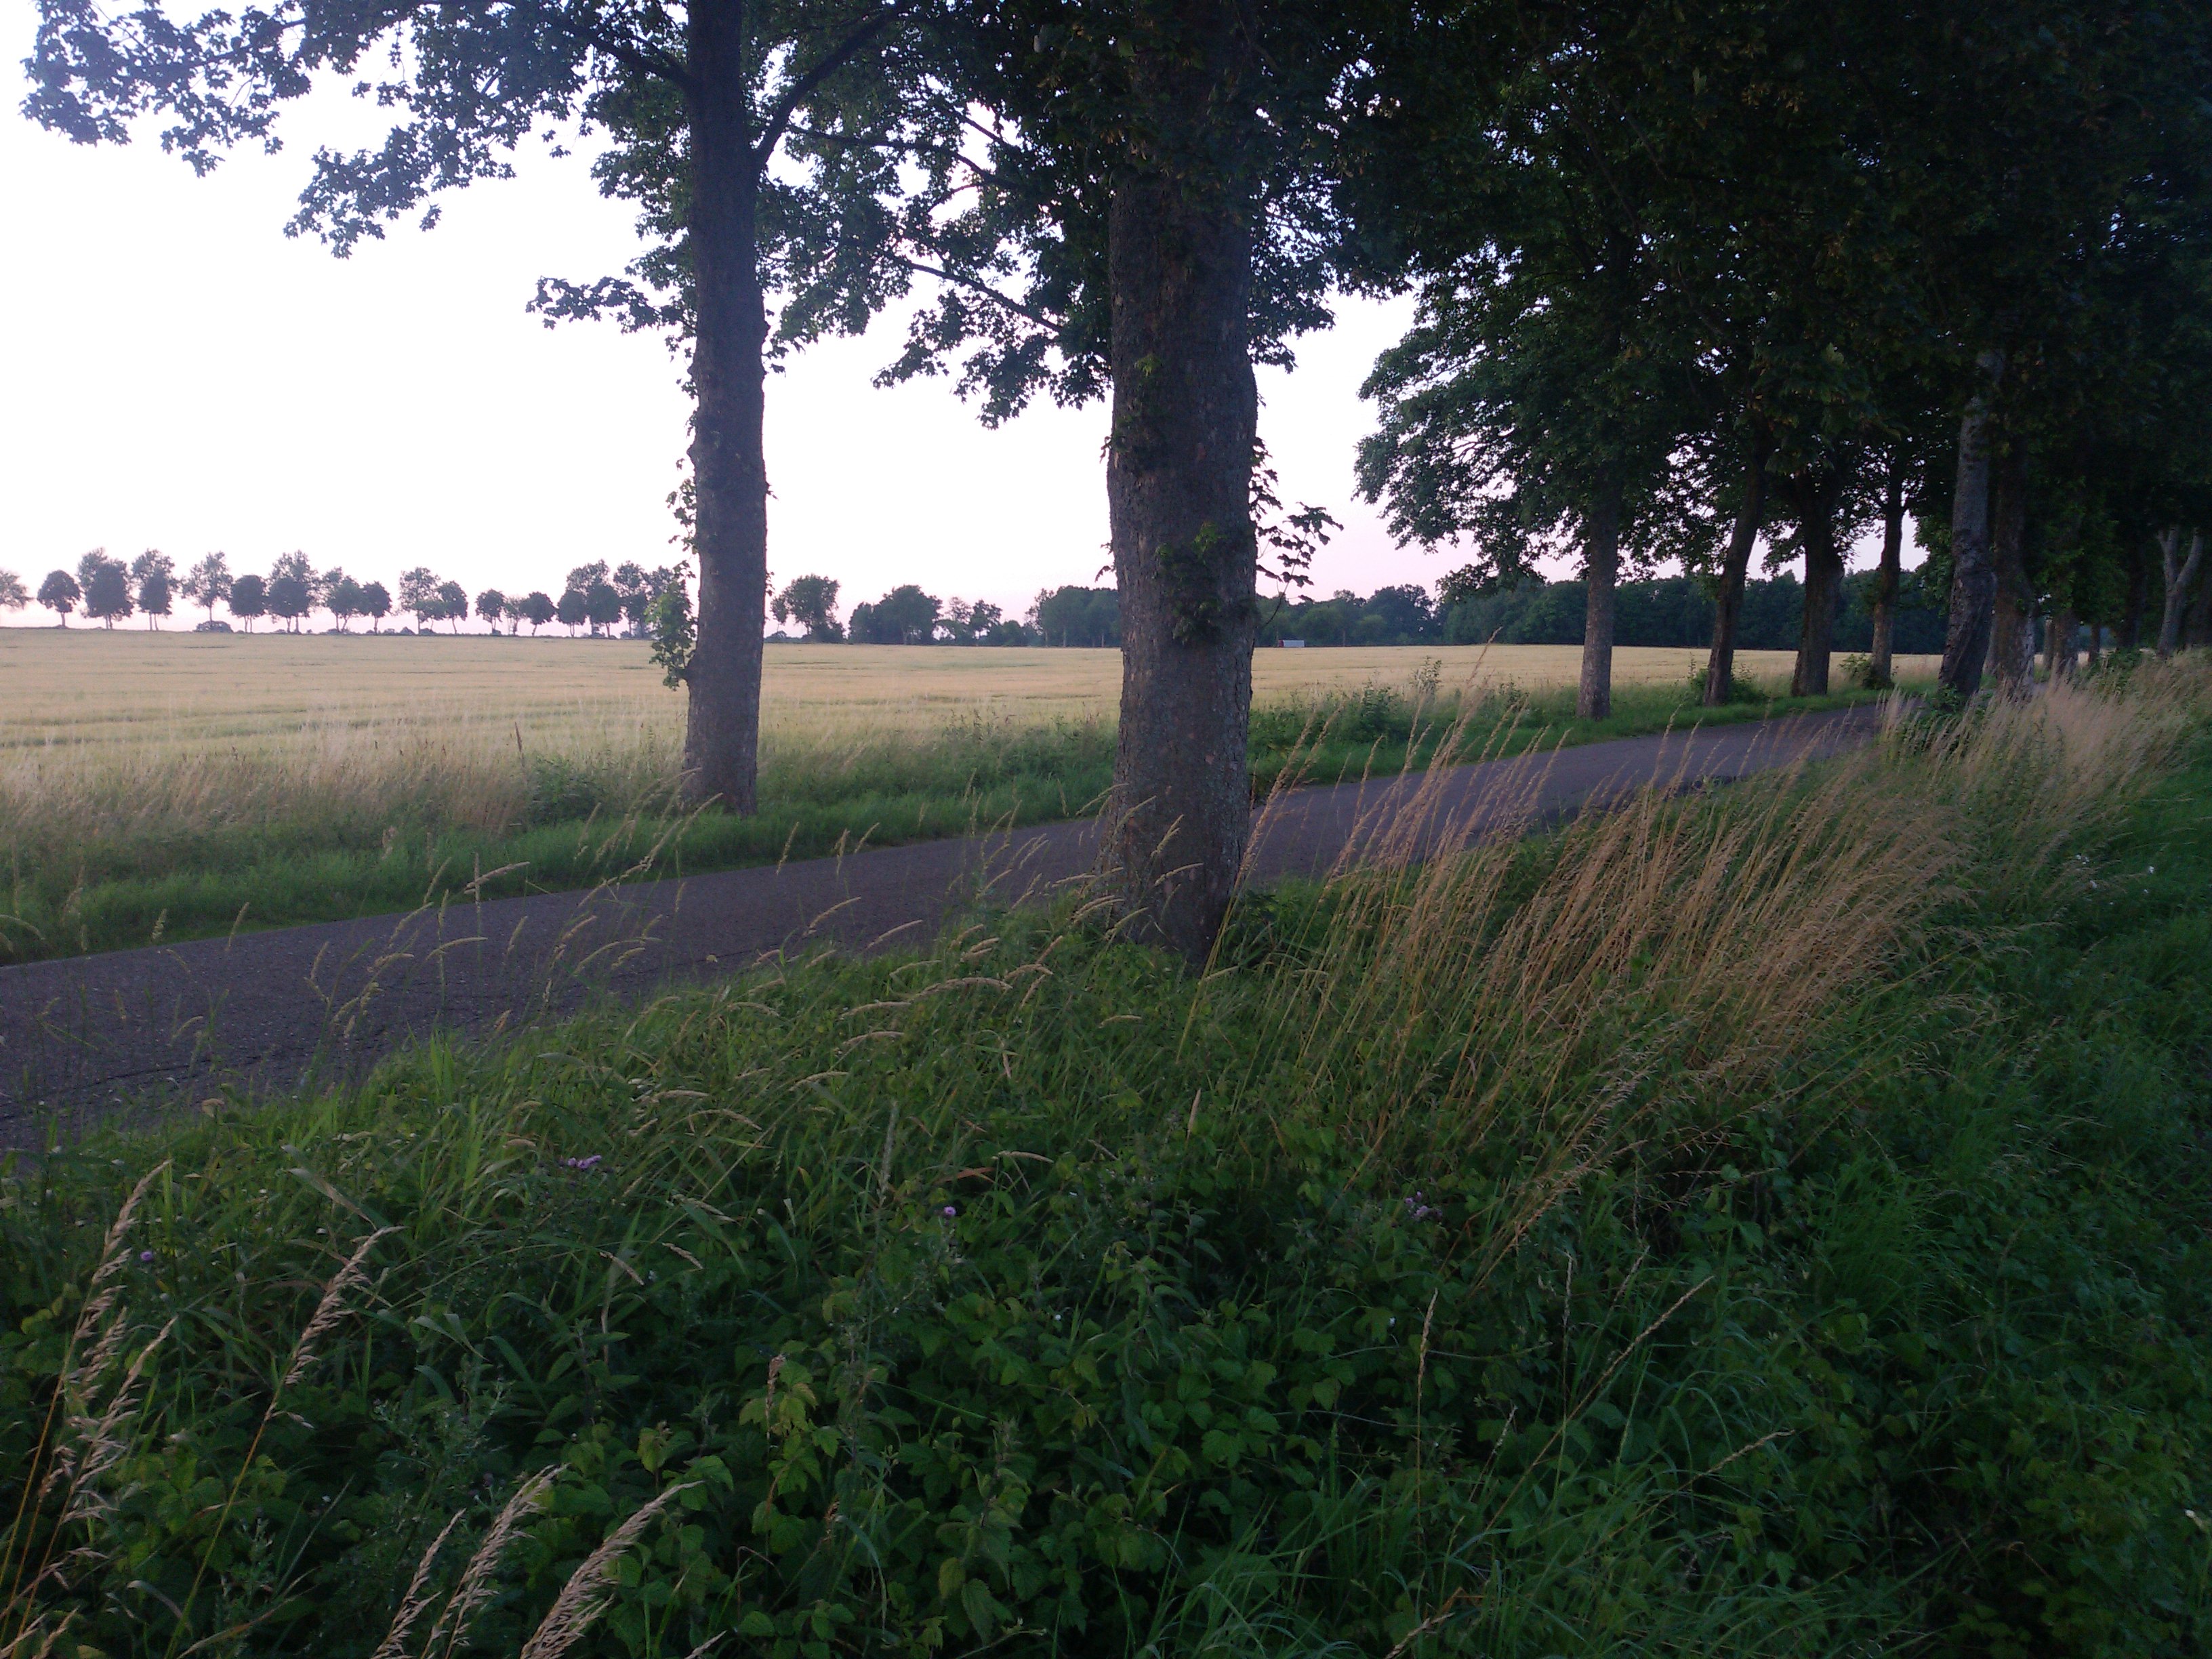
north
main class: Cropland
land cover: Tobacco
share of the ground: > 75 %
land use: Agriculture (excluding fallow land and kitchen gardens)
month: July
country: PL
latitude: 54.0176
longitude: 15.8493
